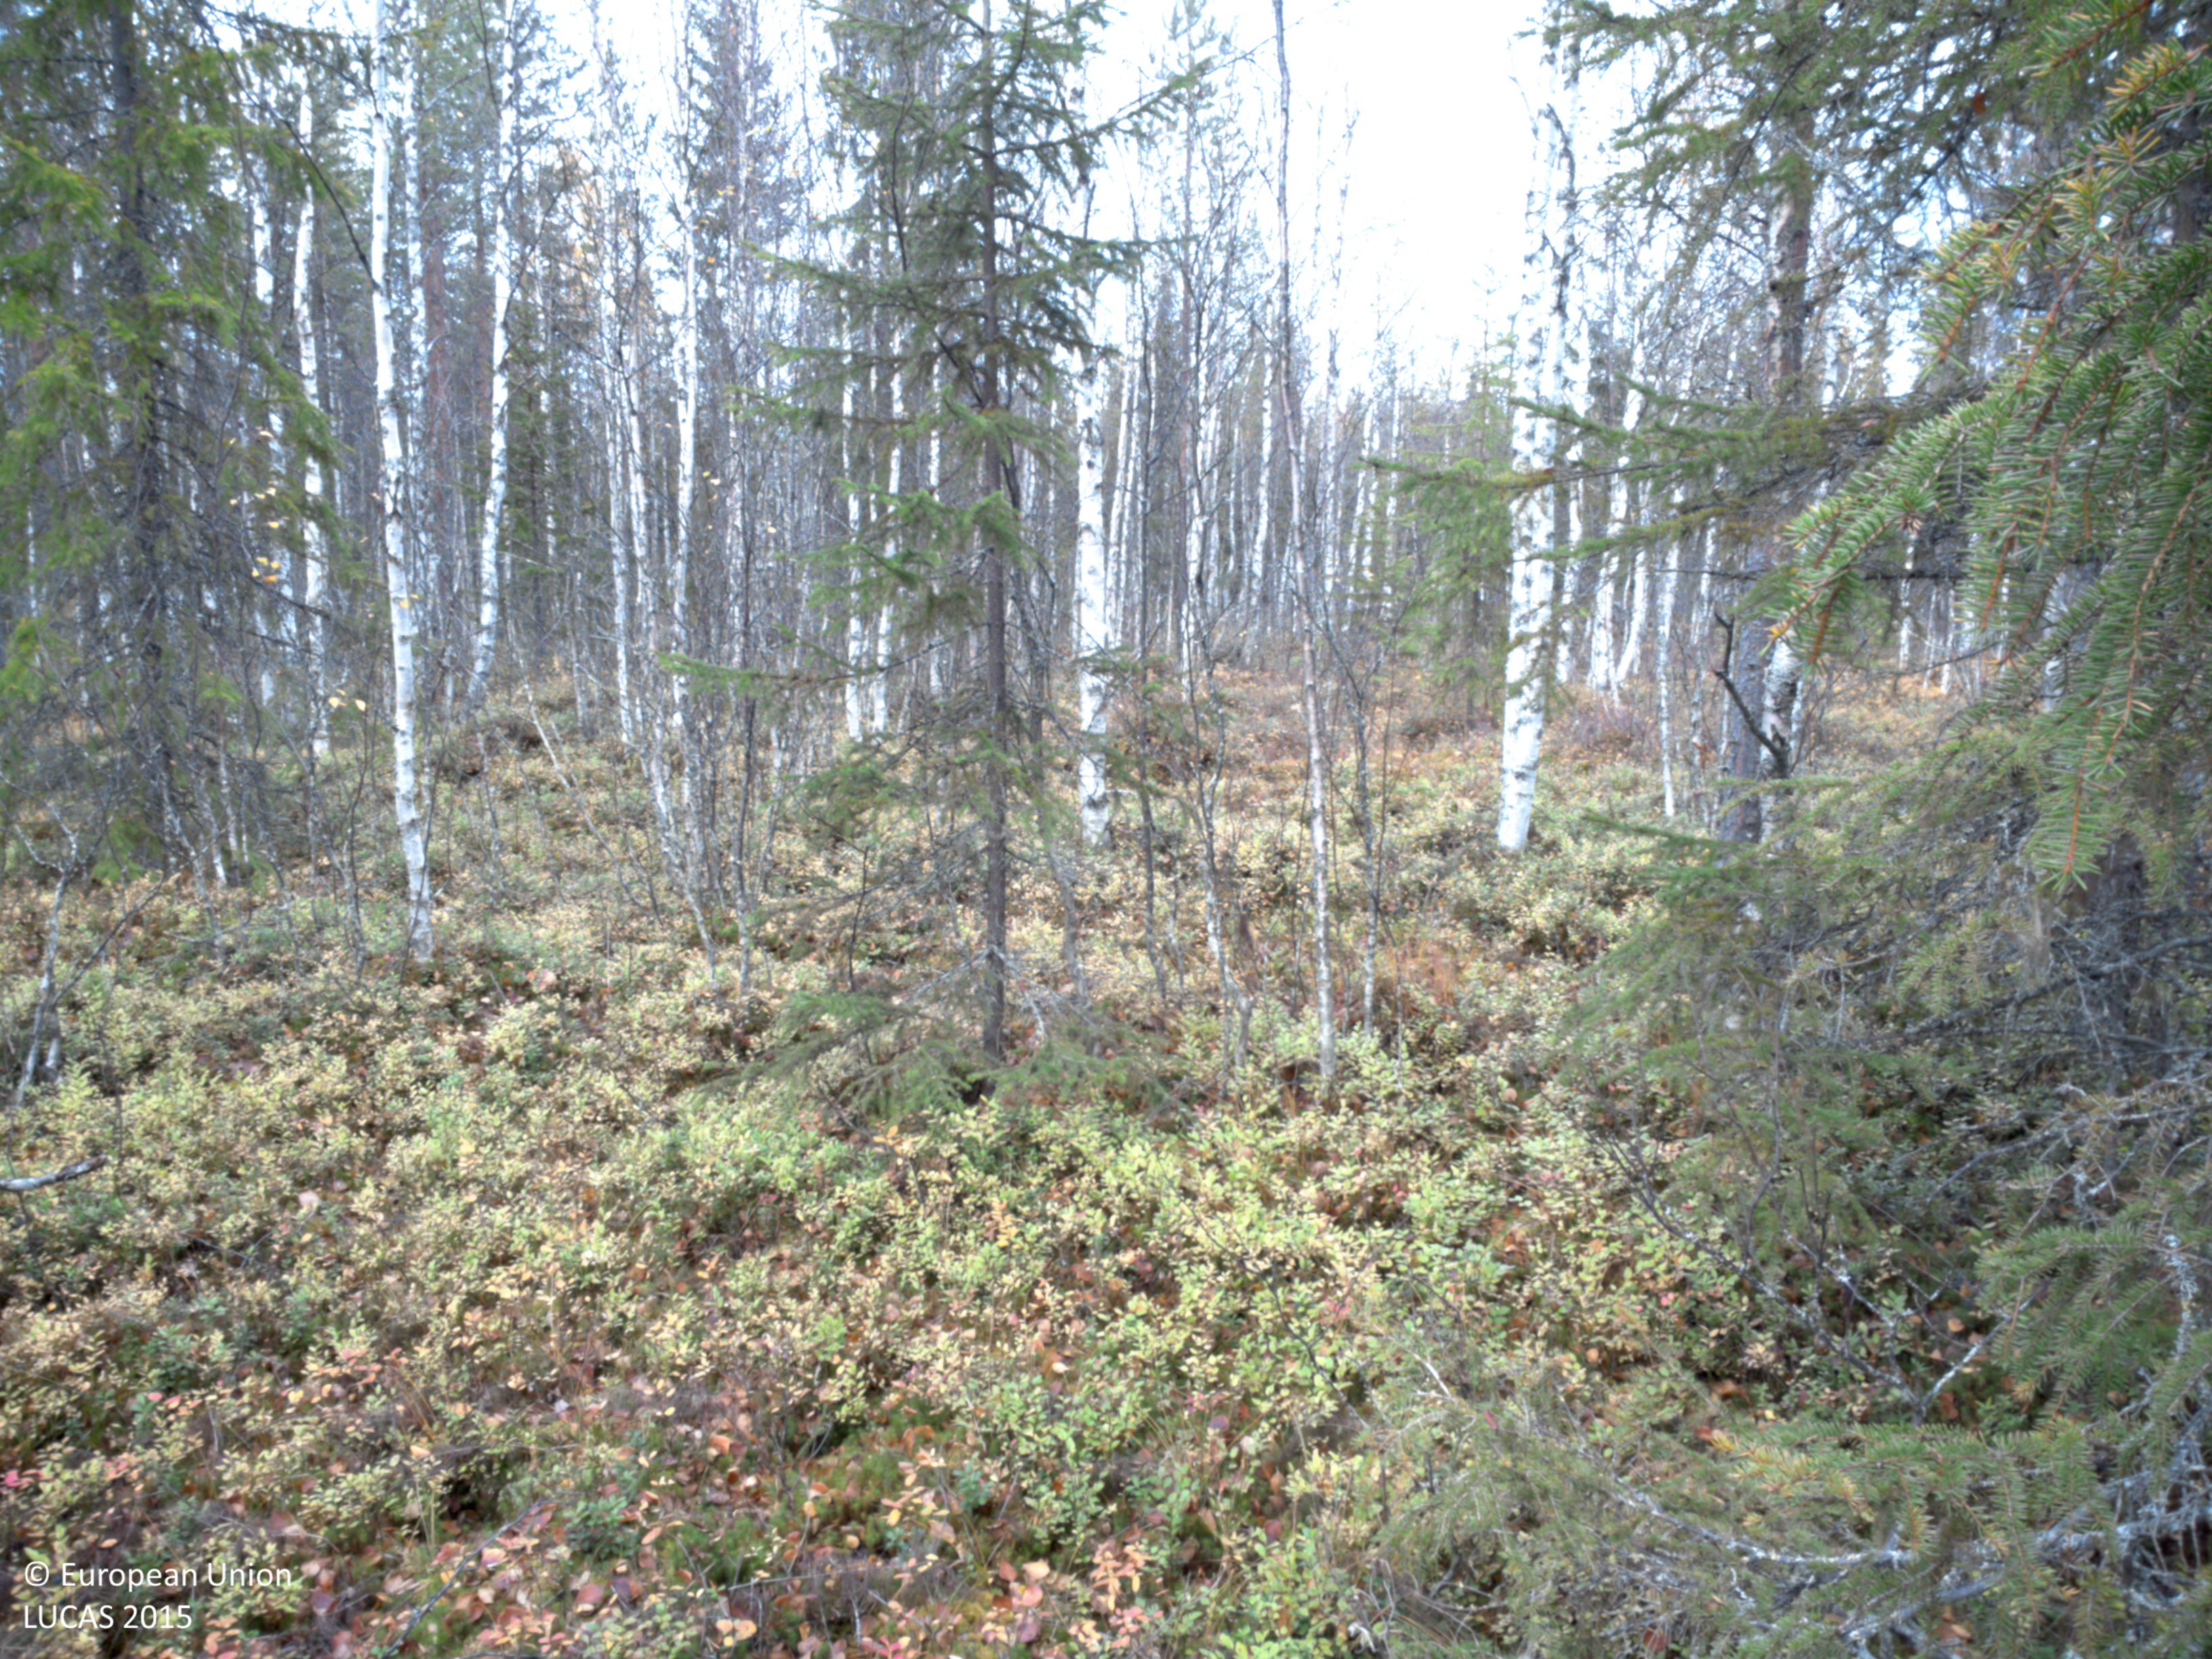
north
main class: Woodland
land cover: Spruce dominated mixed woodland
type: boreal forest
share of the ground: 50 - 75 %
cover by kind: coniferous forest trees 30 %, broadleaved forest trees 30 %, shrubs 30 %, lichens and mosses 10 %
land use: Forestry
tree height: > 5 m
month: October
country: SE
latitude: 64.7924
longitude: 18.0671
